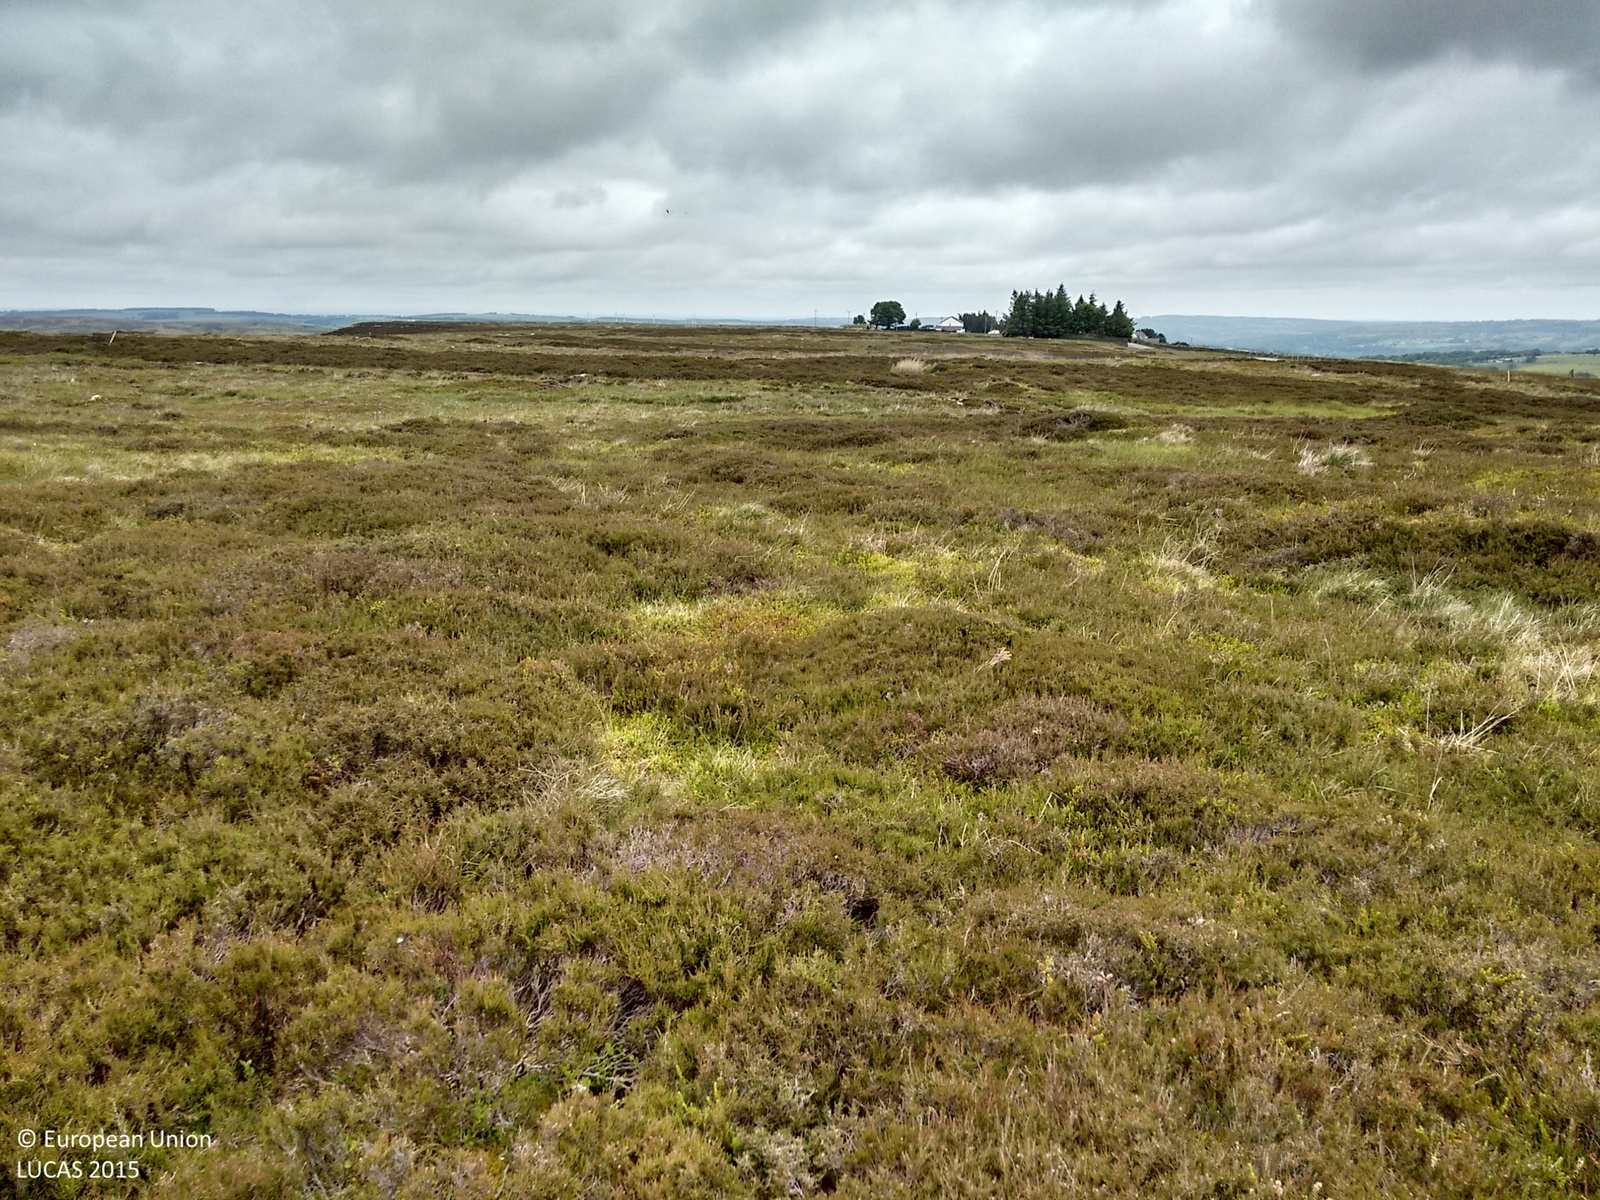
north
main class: Shrubland
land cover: Shrubland without tree cover
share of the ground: > 75 %
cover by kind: shrubs 90 %, herbaceous plants 10 %
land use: Agriculture (excluding fallow land and kitchen gardens)
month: June
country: GB
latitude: 54.8105
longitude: -1.9260
